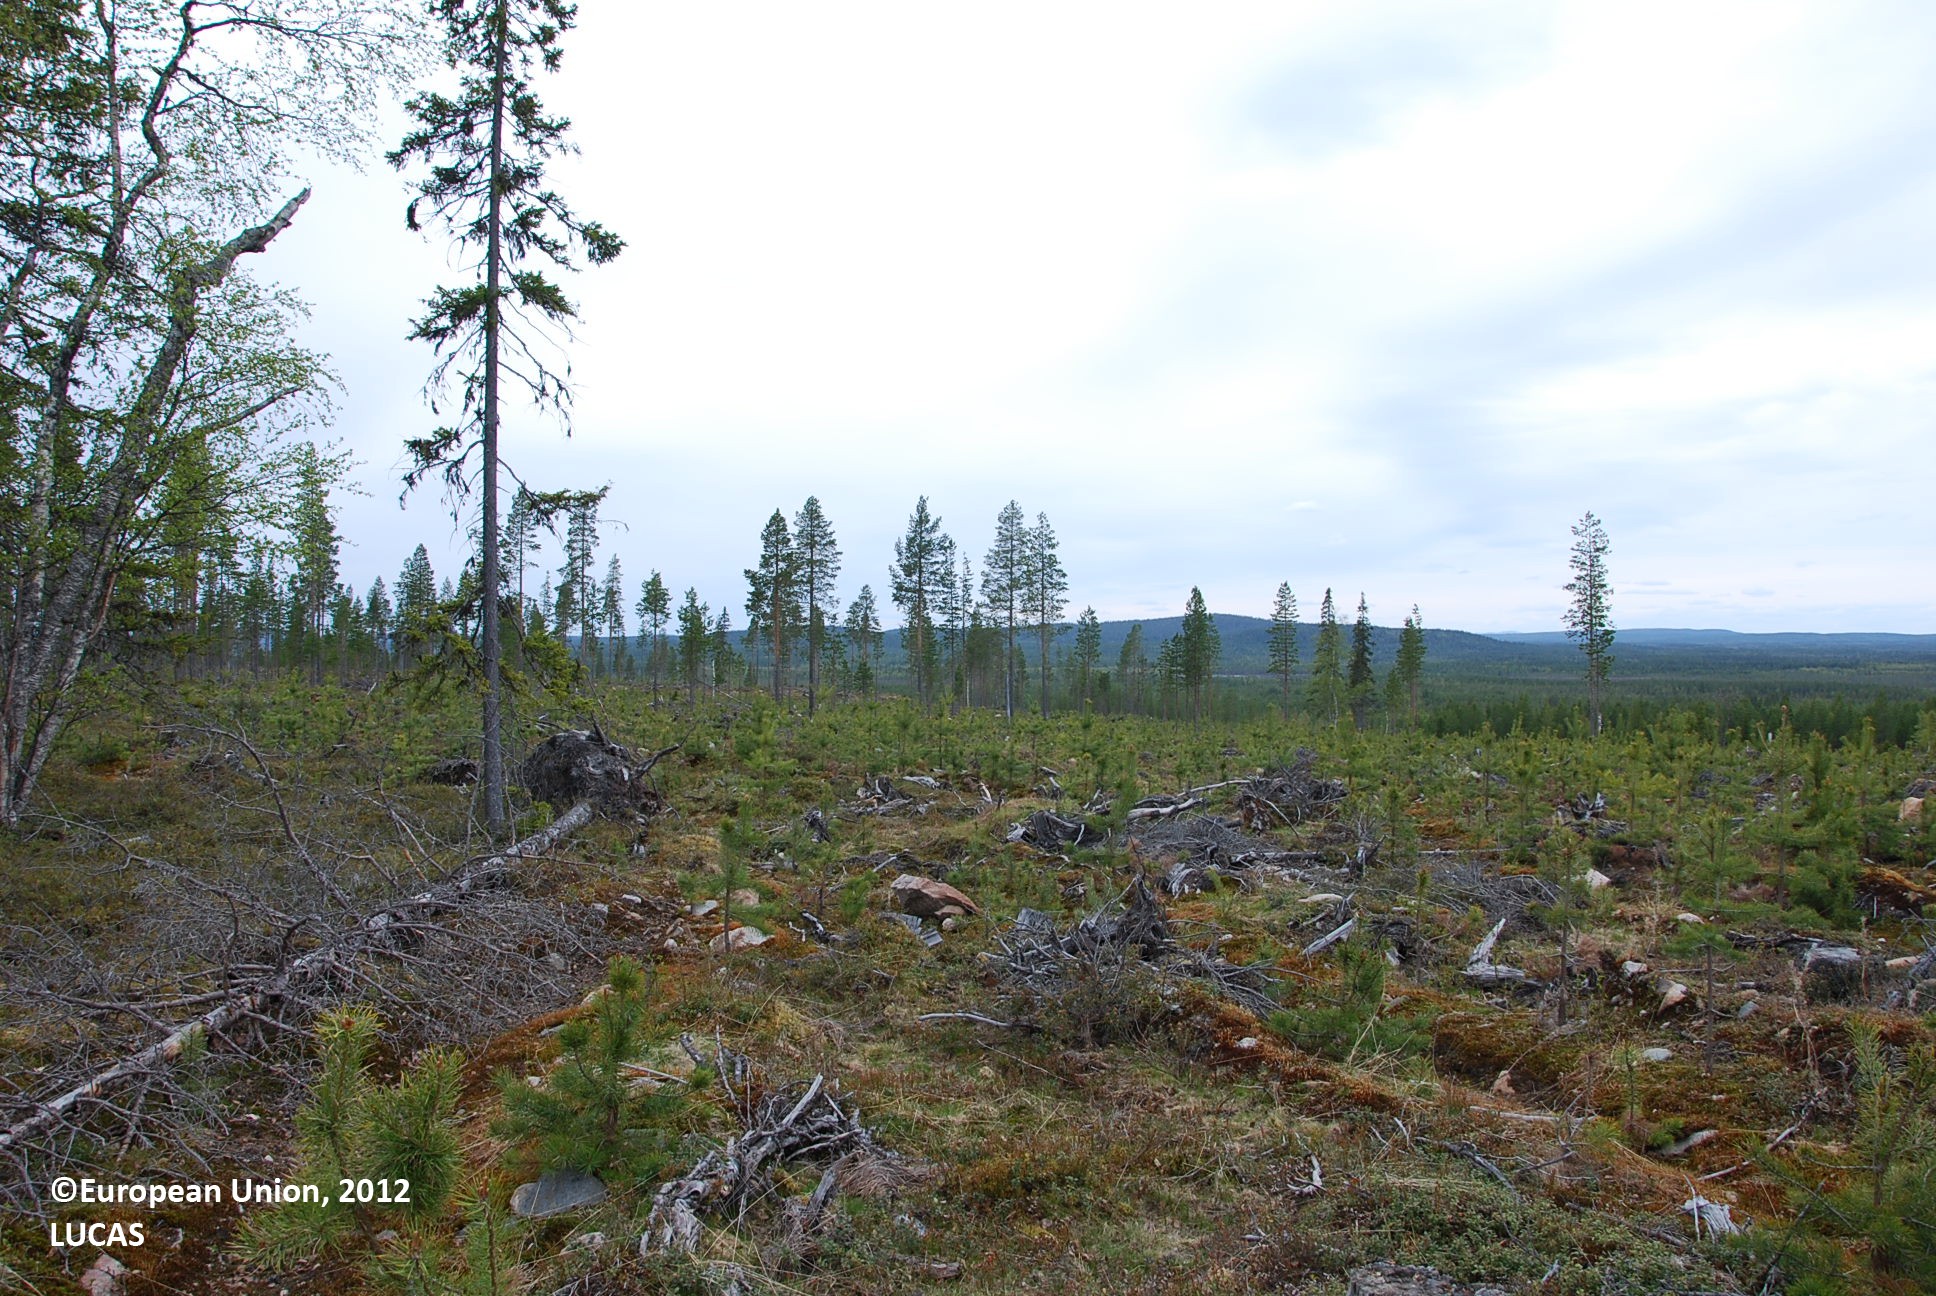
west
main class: Woodland
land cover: Pine dominated coniferous woodland
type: boreal forest
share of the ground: 10 - 25 %
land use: Forestry
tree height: < 5 m
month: June
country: FI
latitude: 66.8094
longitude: 28.1759
